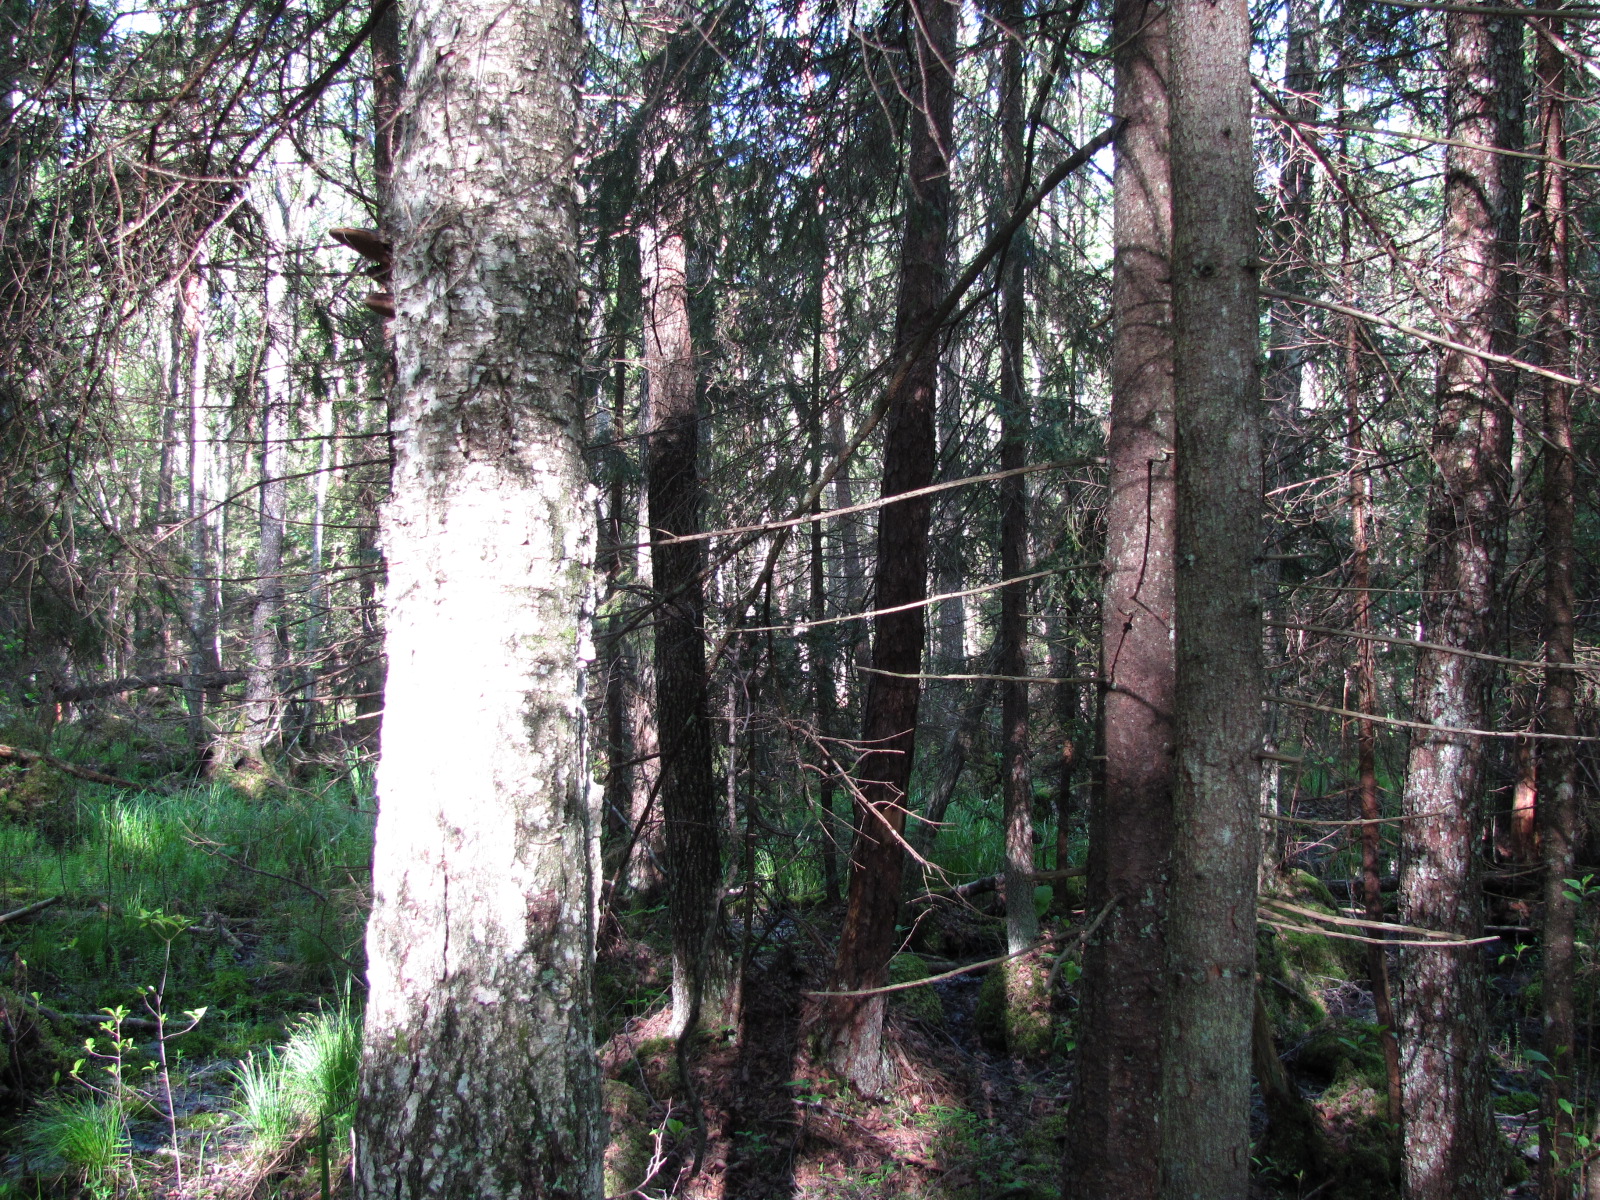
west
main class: Woodland
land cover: Spruce dominated mixed woodland
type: hemiboreal forest and nemoral coniferous forest and mixed broadleaved-coniferous forest
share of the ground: > 75 %
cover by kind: broadleaved forest trees 70 %, coniferous forest trees 30 %
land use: Forestry
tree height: > 5 m
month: May
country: LV
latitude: 56.6584
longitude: 24.1664
